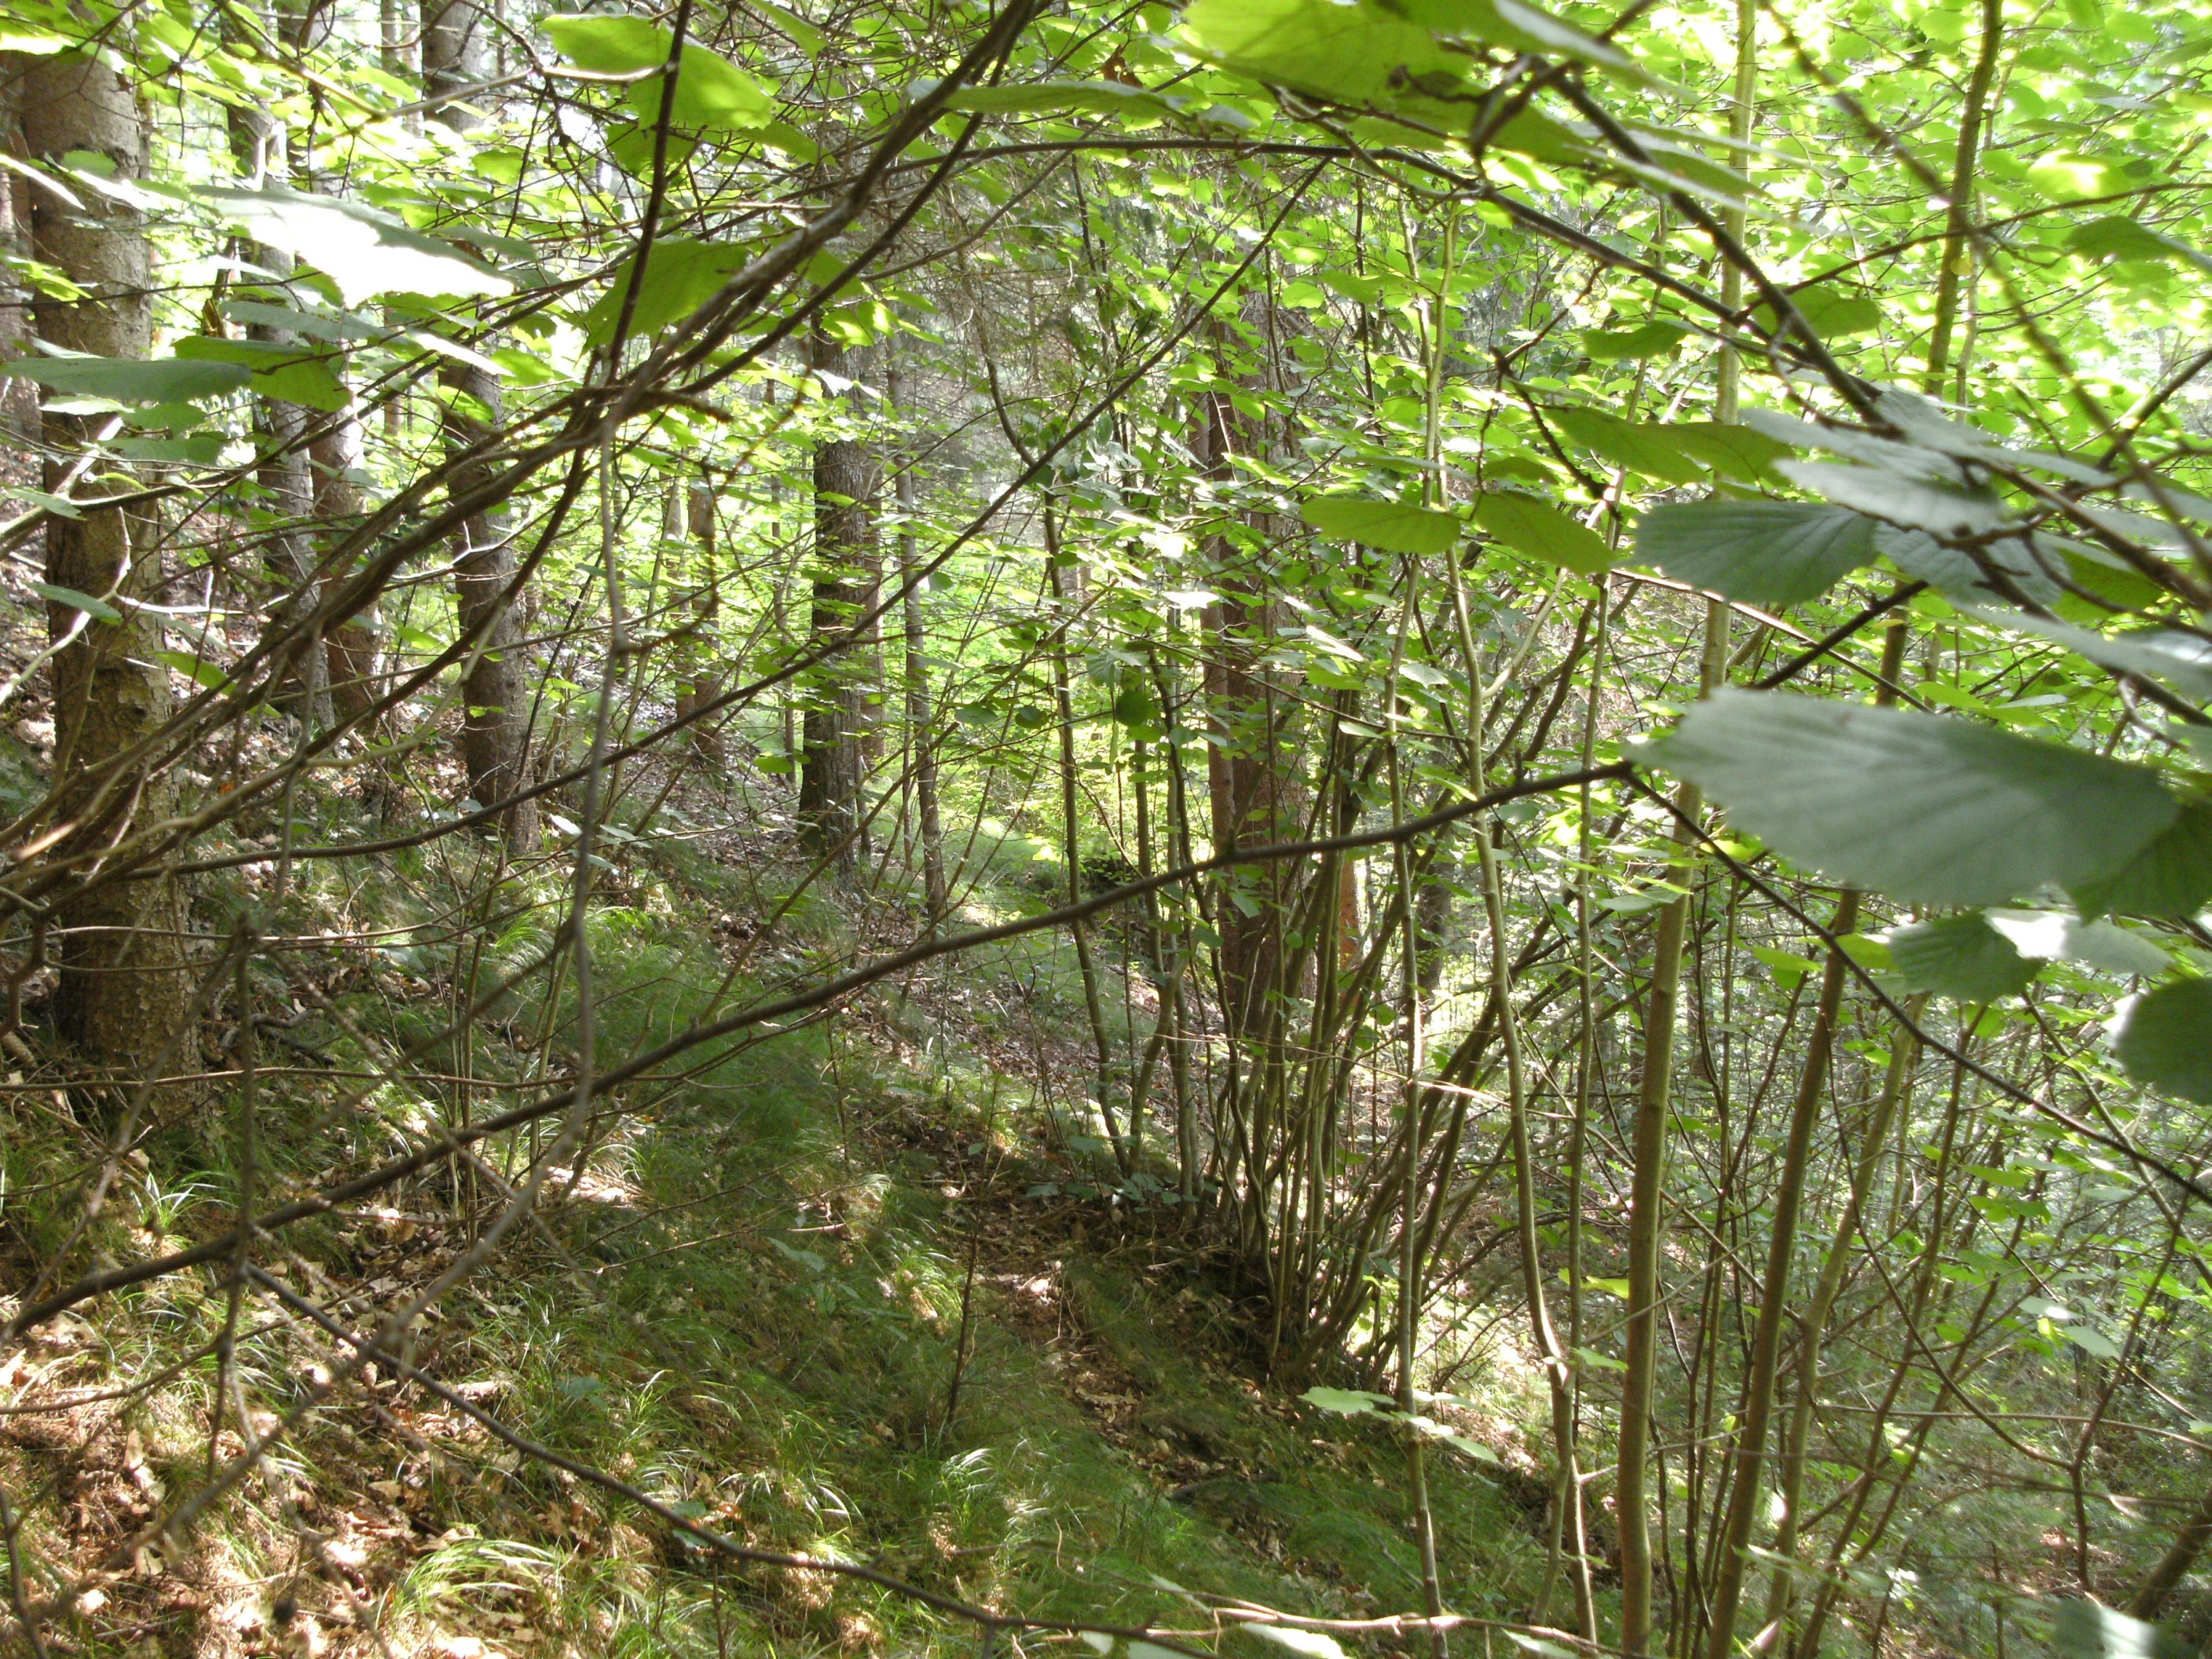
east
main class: Woodland
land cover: Spruce dominated coniferous woodland
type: hemiboreal forest and nemoral coniferous forest and mixed broadleaved-coniferous forest
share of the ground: 50 - 75 %
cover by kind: coniferous forest trees 60 %, shrubs 20 %, broadleaved forest trees 10 %, herbaceous plants 5 %, unconsolidated bare surface 5 %
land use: Forestry
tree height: > 5 m
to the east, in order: Spruce dominated coniferous woodland; Grassland with sparse tree/shrub cover; Spruce dominated mixed woodland; Other mixed woodland; Spruce dominated mixed woodland; Shrubland with sparse tree cover; Tracks; Spruce dominated mixed woodland; Other mixed woodland
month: July
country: AT
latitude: 46.6540
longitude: 14.8983
